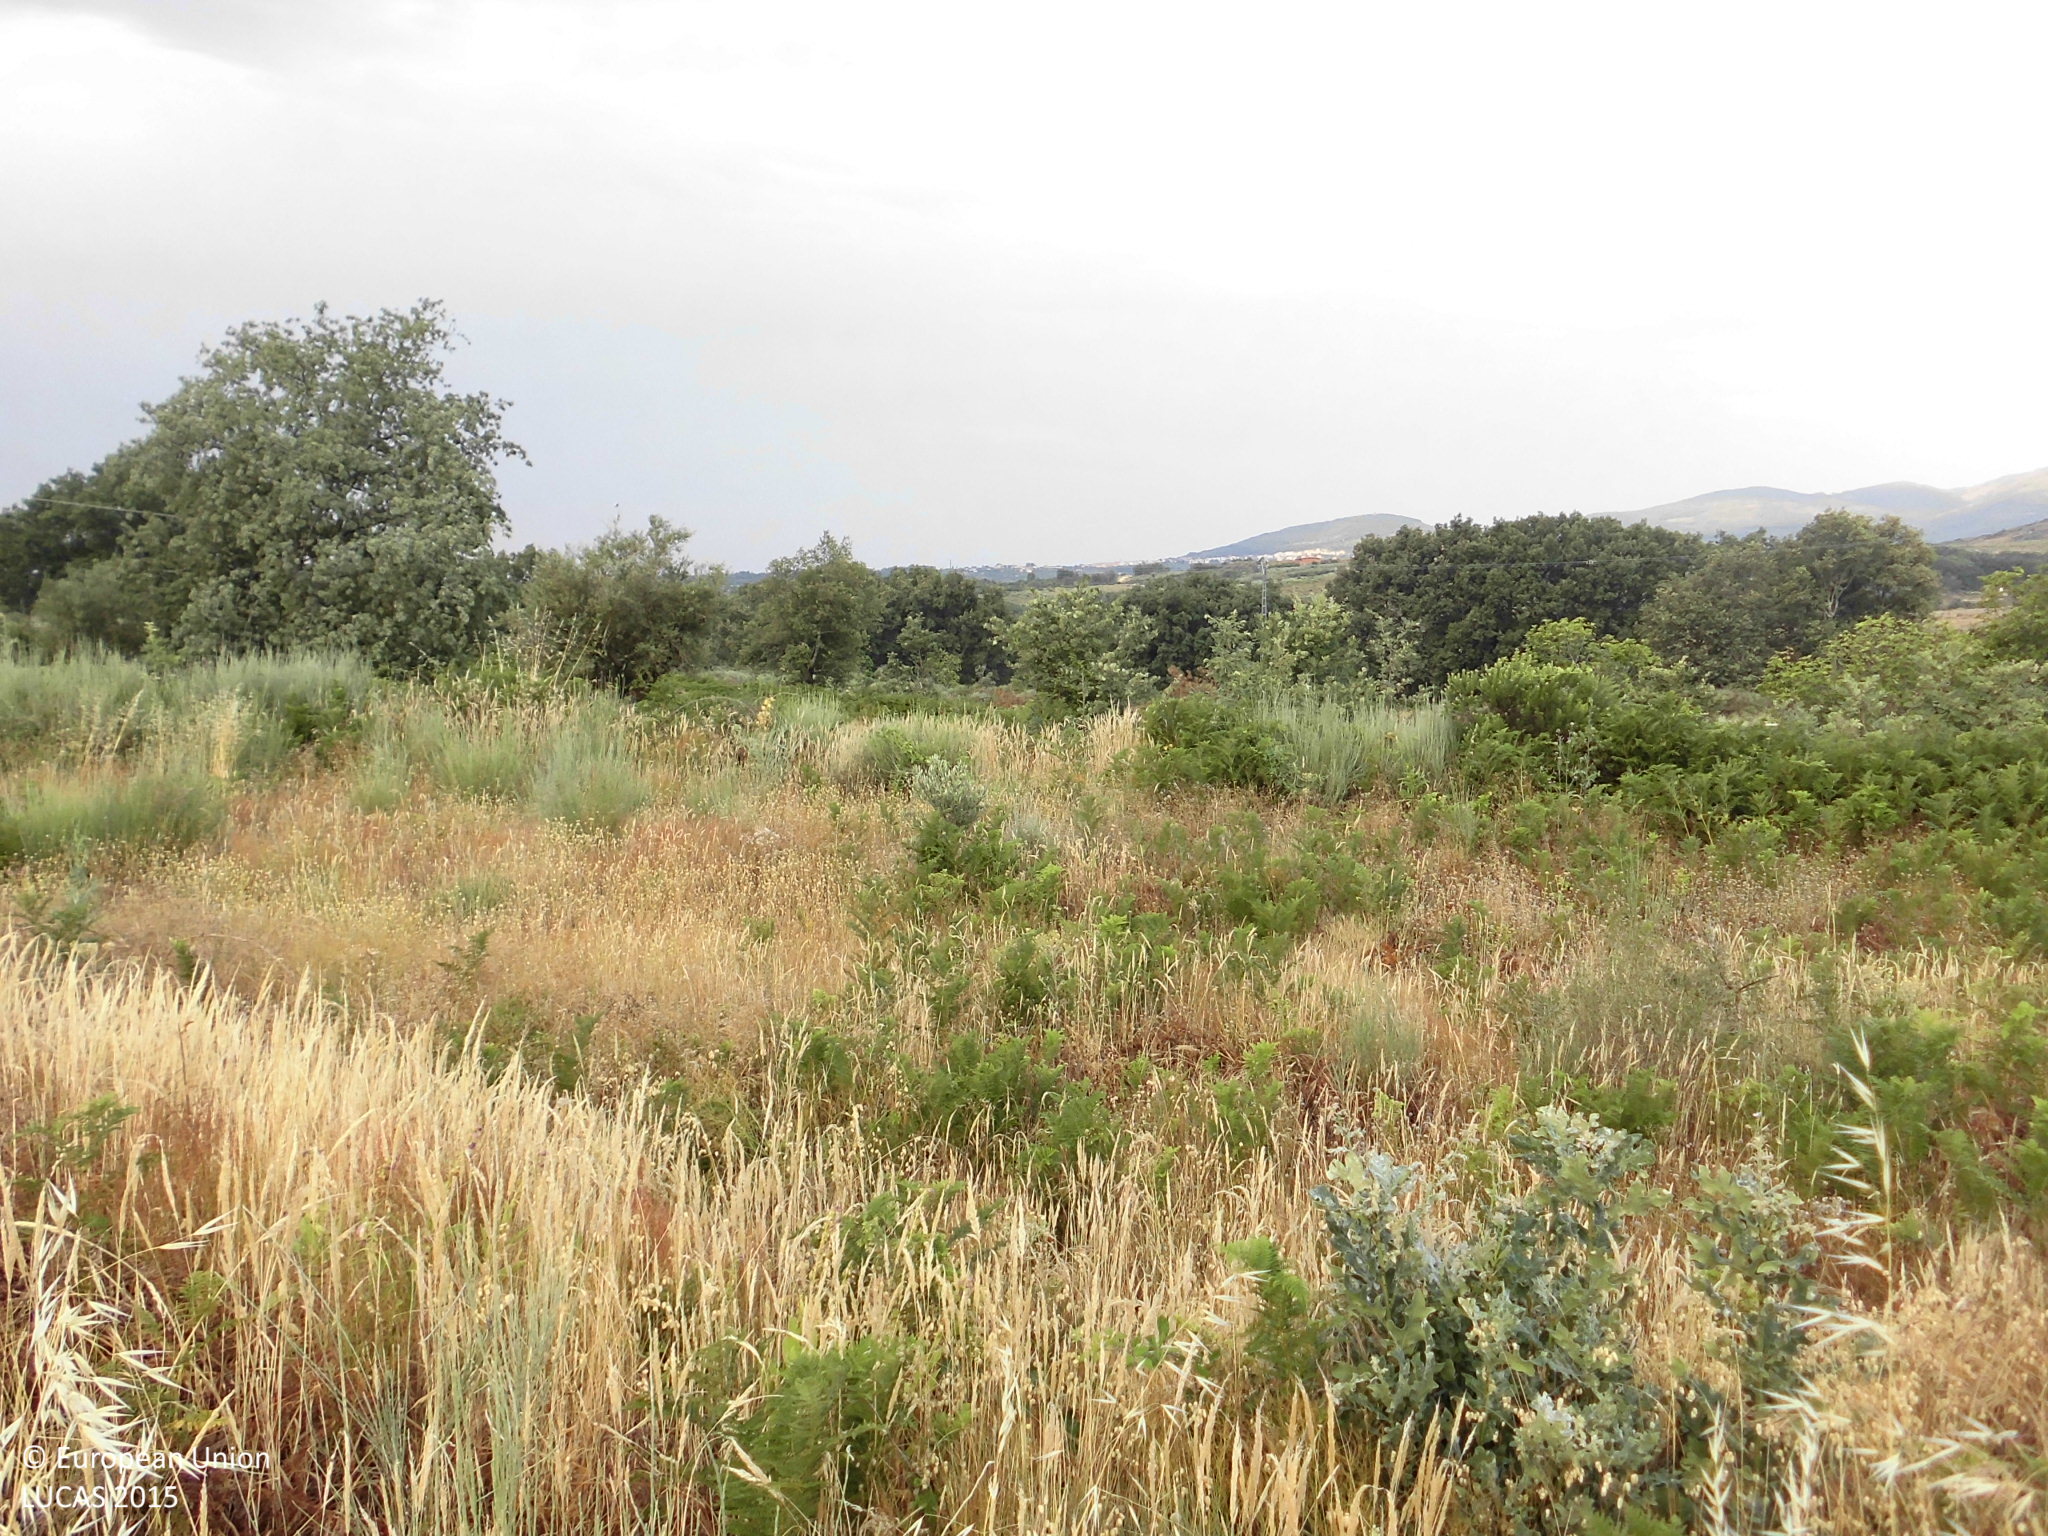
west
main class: Cropland
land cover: Olive groves
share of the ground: < 10 %
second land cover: Spontaneously vegetated surfaces
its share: > 75 %
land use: Agriculture (excluding fallow land and kitchen gardens)
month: June
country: ES
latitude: 40.0976
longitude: -5.7011
